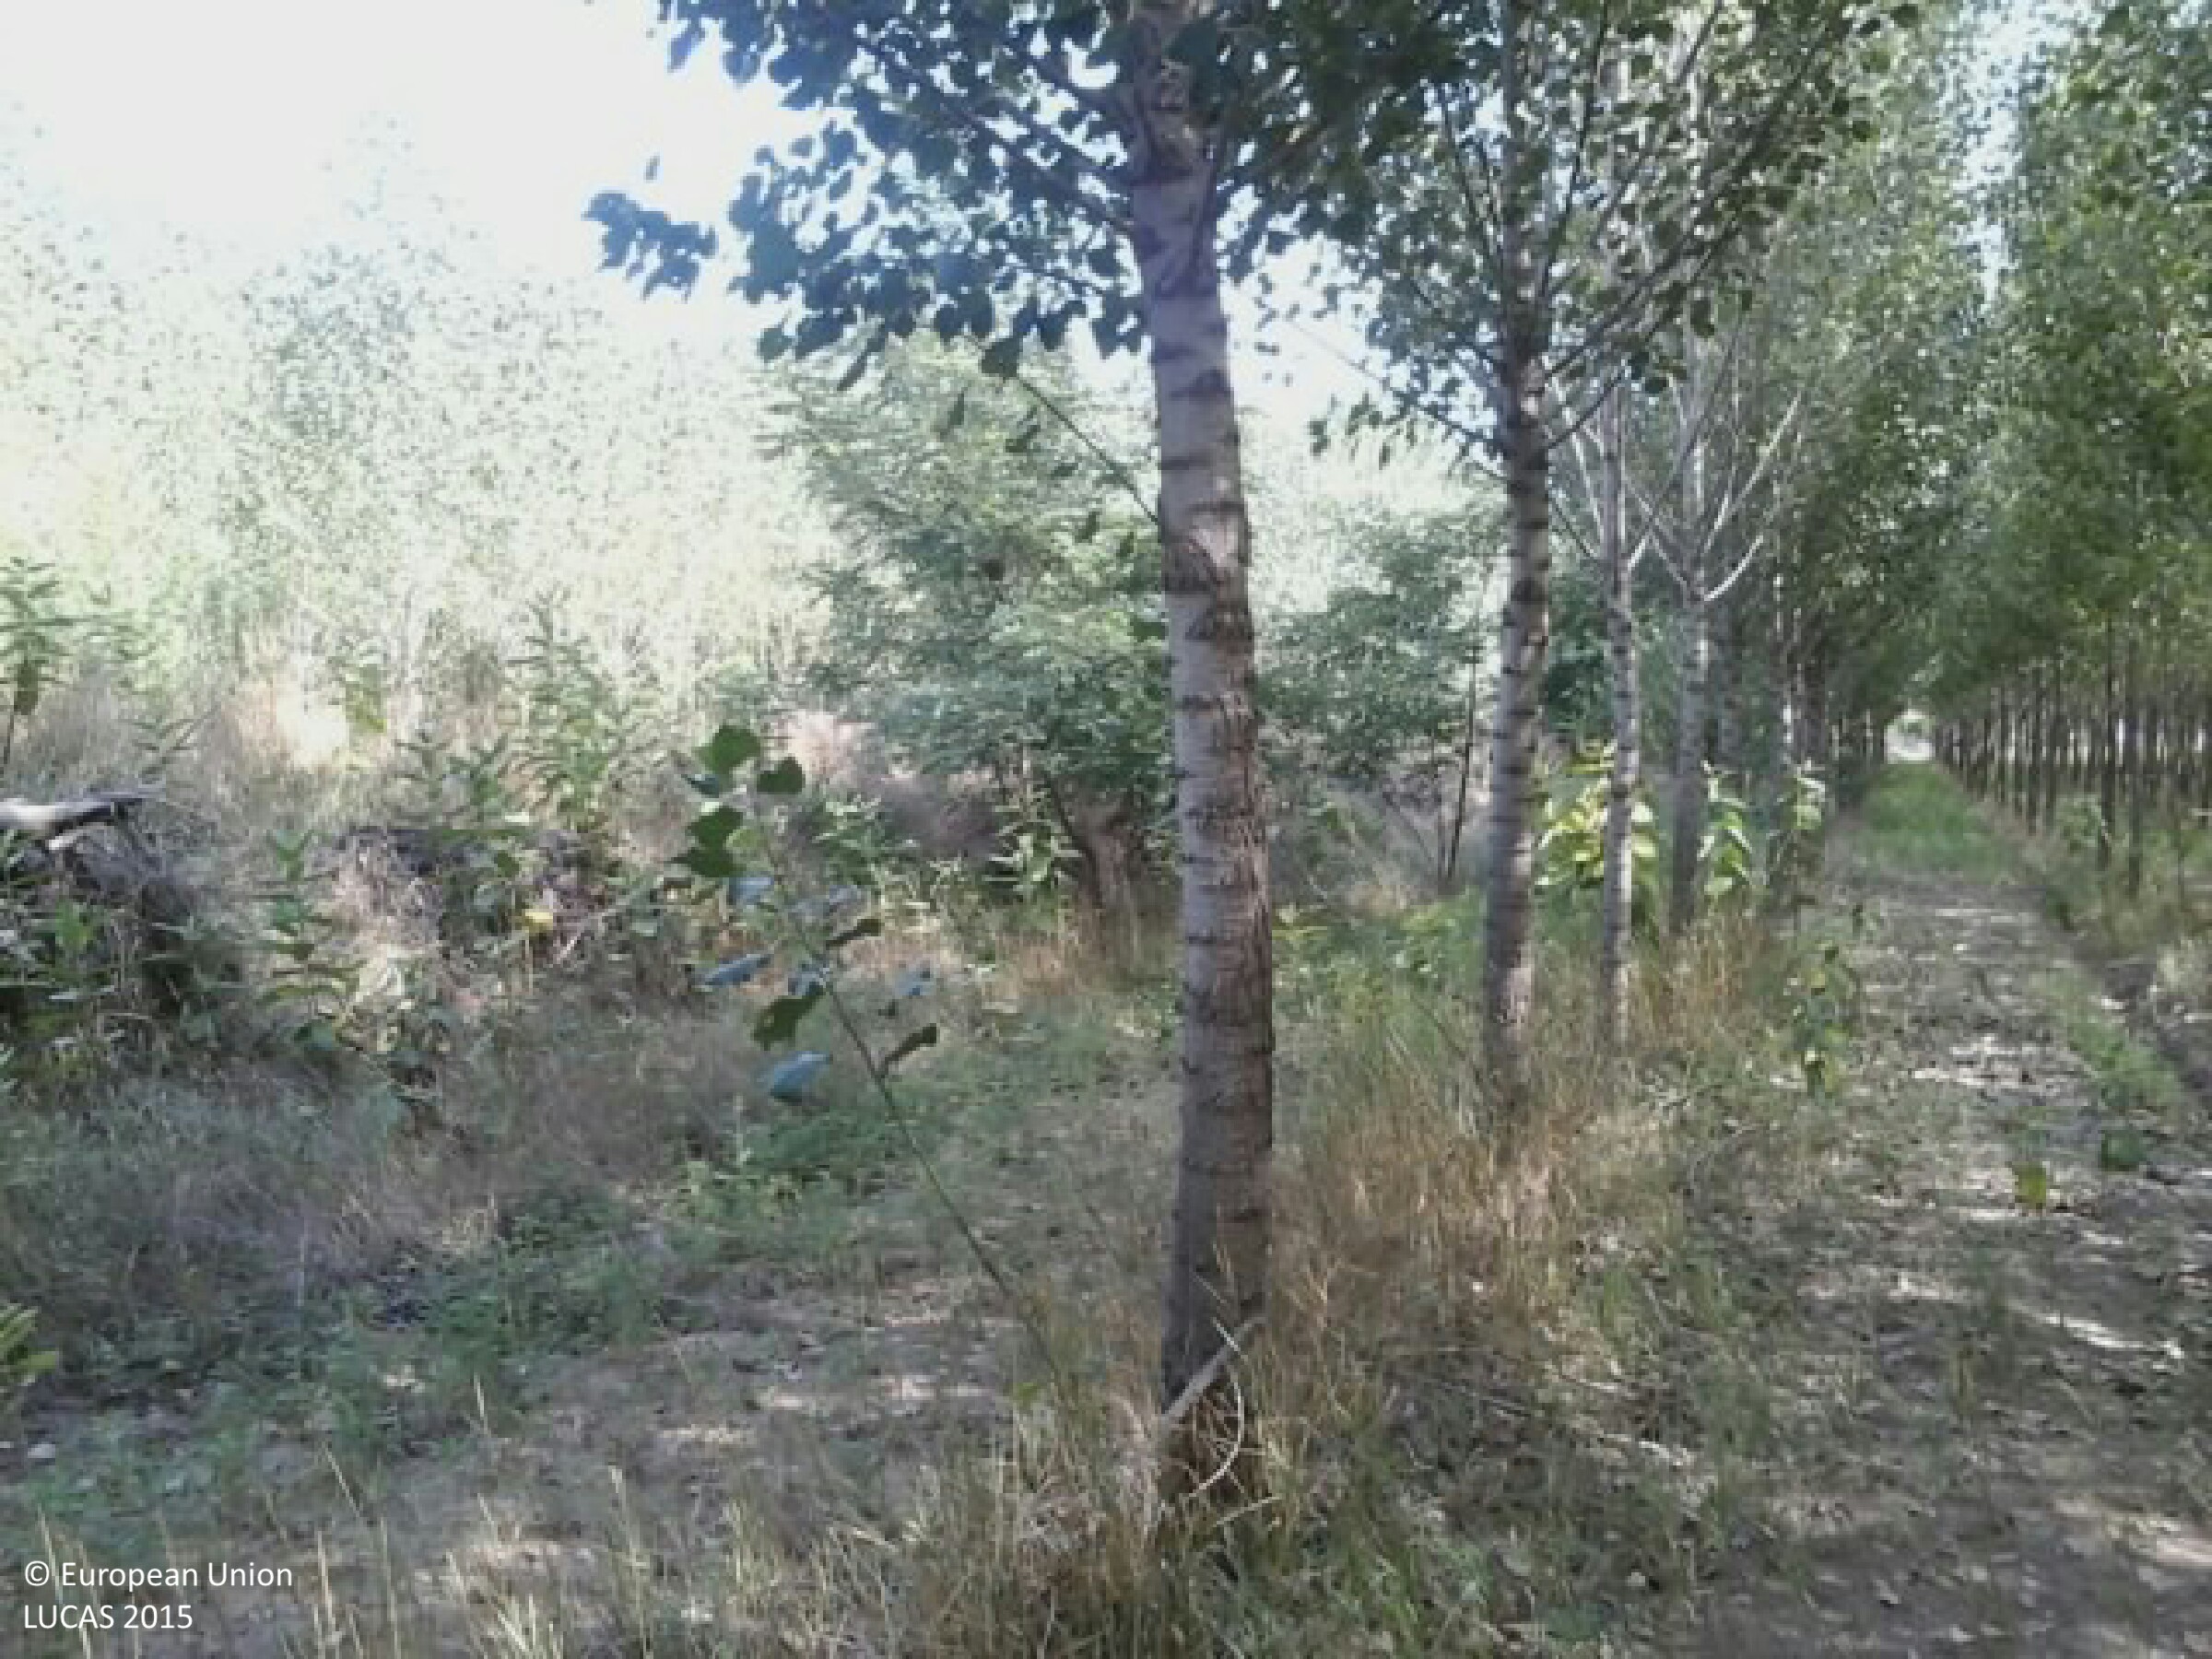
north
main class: Woodland
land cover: Broadleaved woodland
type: non-riverine alder, birch or aspen forest
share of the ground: 50 - 75 %
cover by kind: broadleaved forest trees 85 %, unconsolidated bare surface 15 %
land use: Forestry
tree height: > 5 m
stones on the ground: < 10 %
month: August
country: HU
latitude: 47.0782
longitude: 19.8080
